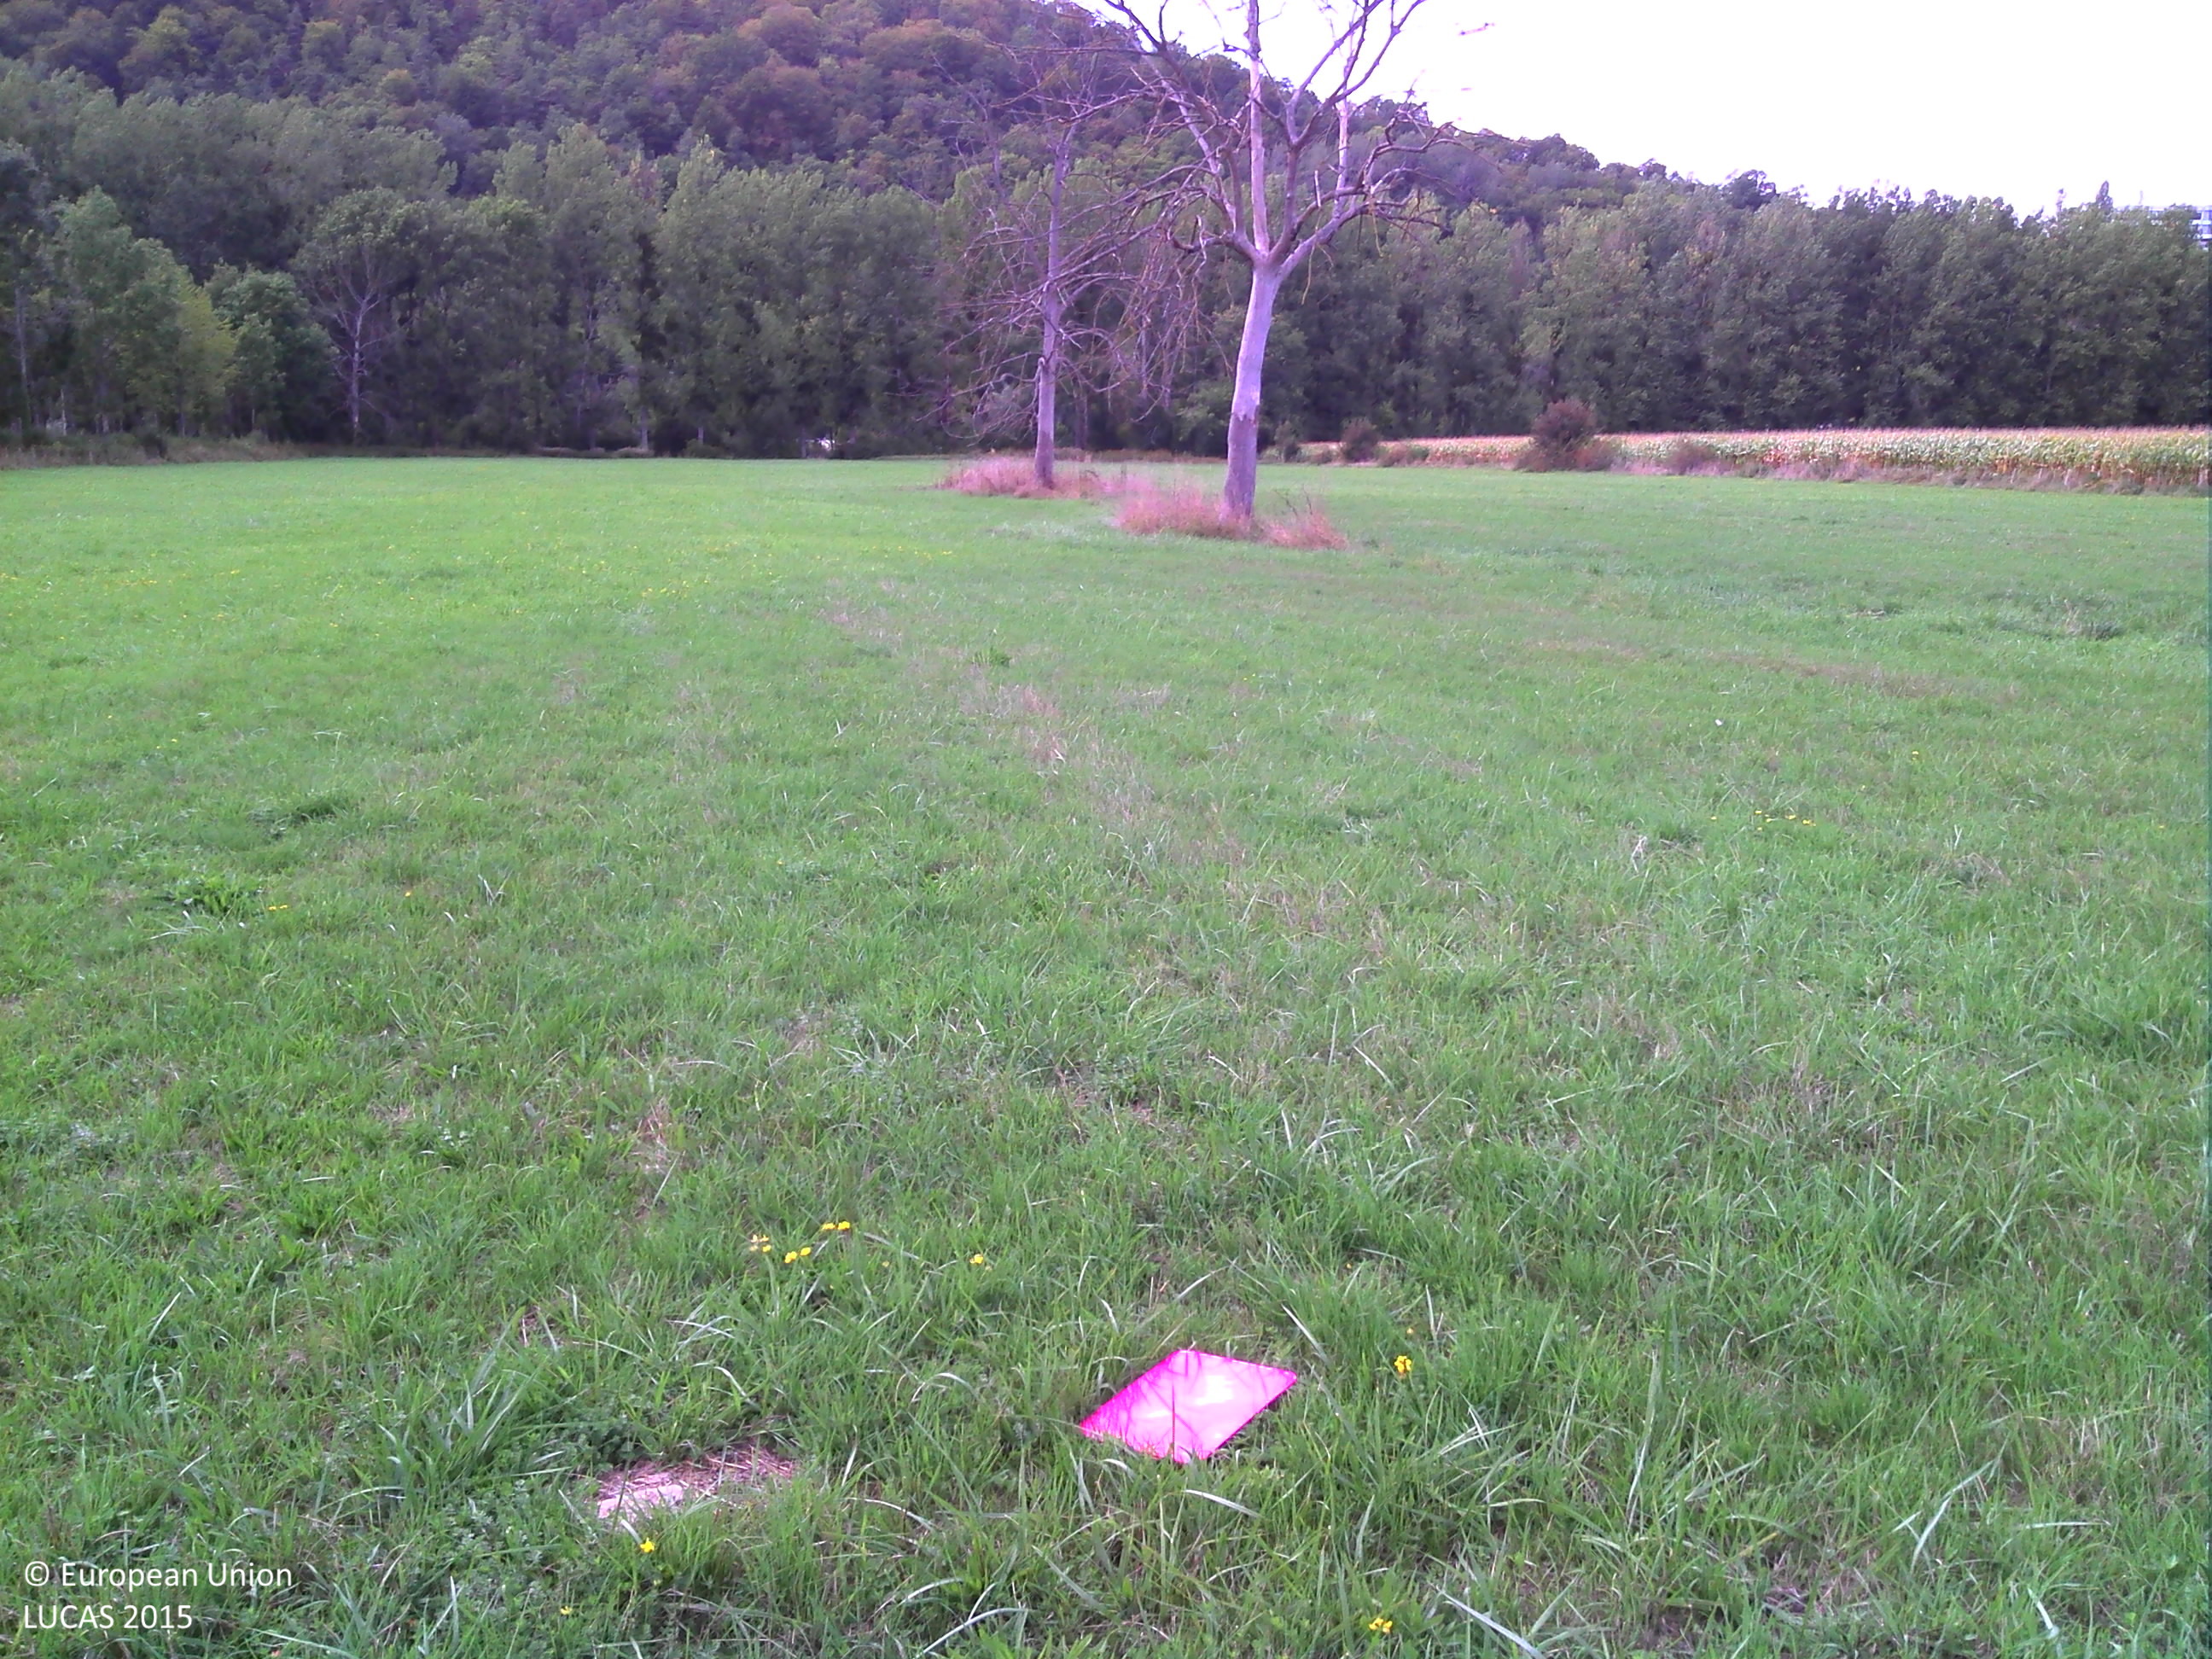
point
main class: Grassland
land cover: Grassland without tree/shrub cover
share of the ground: > 75 %
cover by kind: herbaceous plants 100 %
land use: Agriculture (excluding fallow land and kitchen gardens)
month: September
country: FR
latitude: 48.2227
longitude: 4.7082
